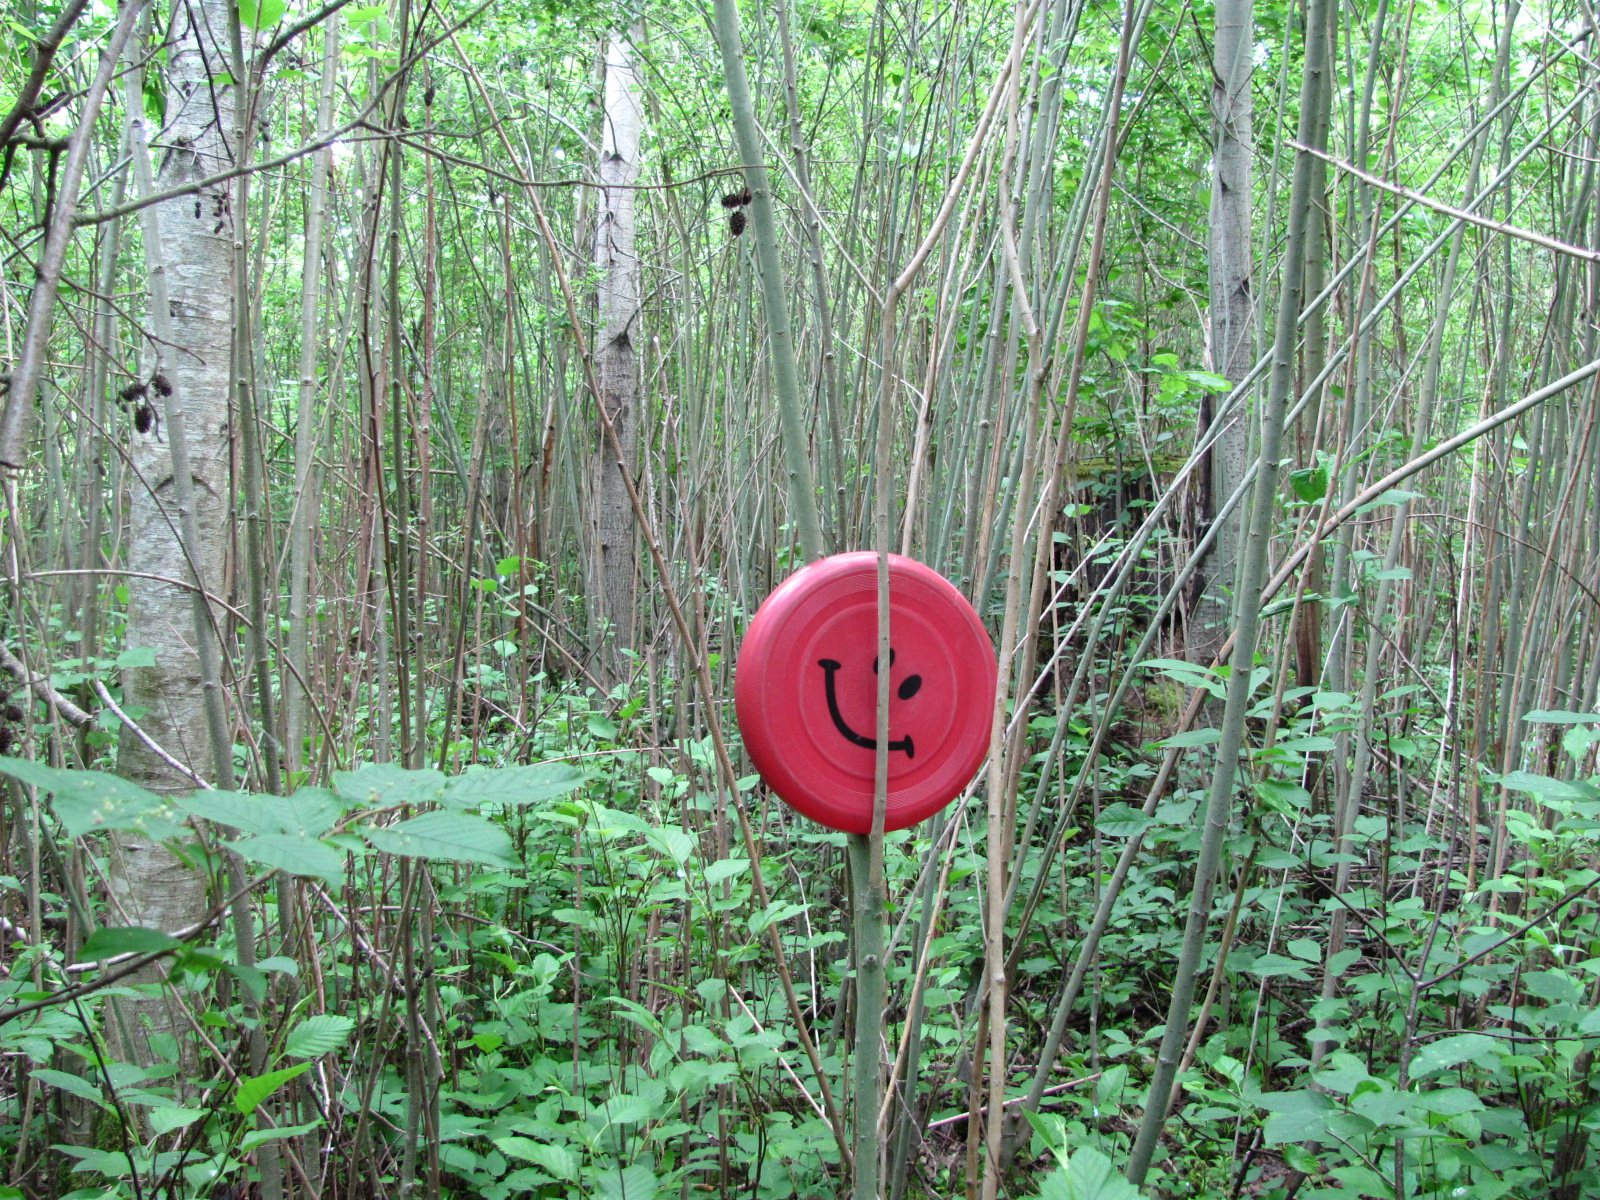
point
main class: Woodland
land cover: Broadleaved woodland
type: non-riverine alder, birch or aspen forest
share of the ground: > 75 %
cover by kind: broadleaved forest trees 100 %
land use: Forestry
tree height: > 5 m
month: June
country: LV
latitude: 56.3421
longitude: 24.2138
